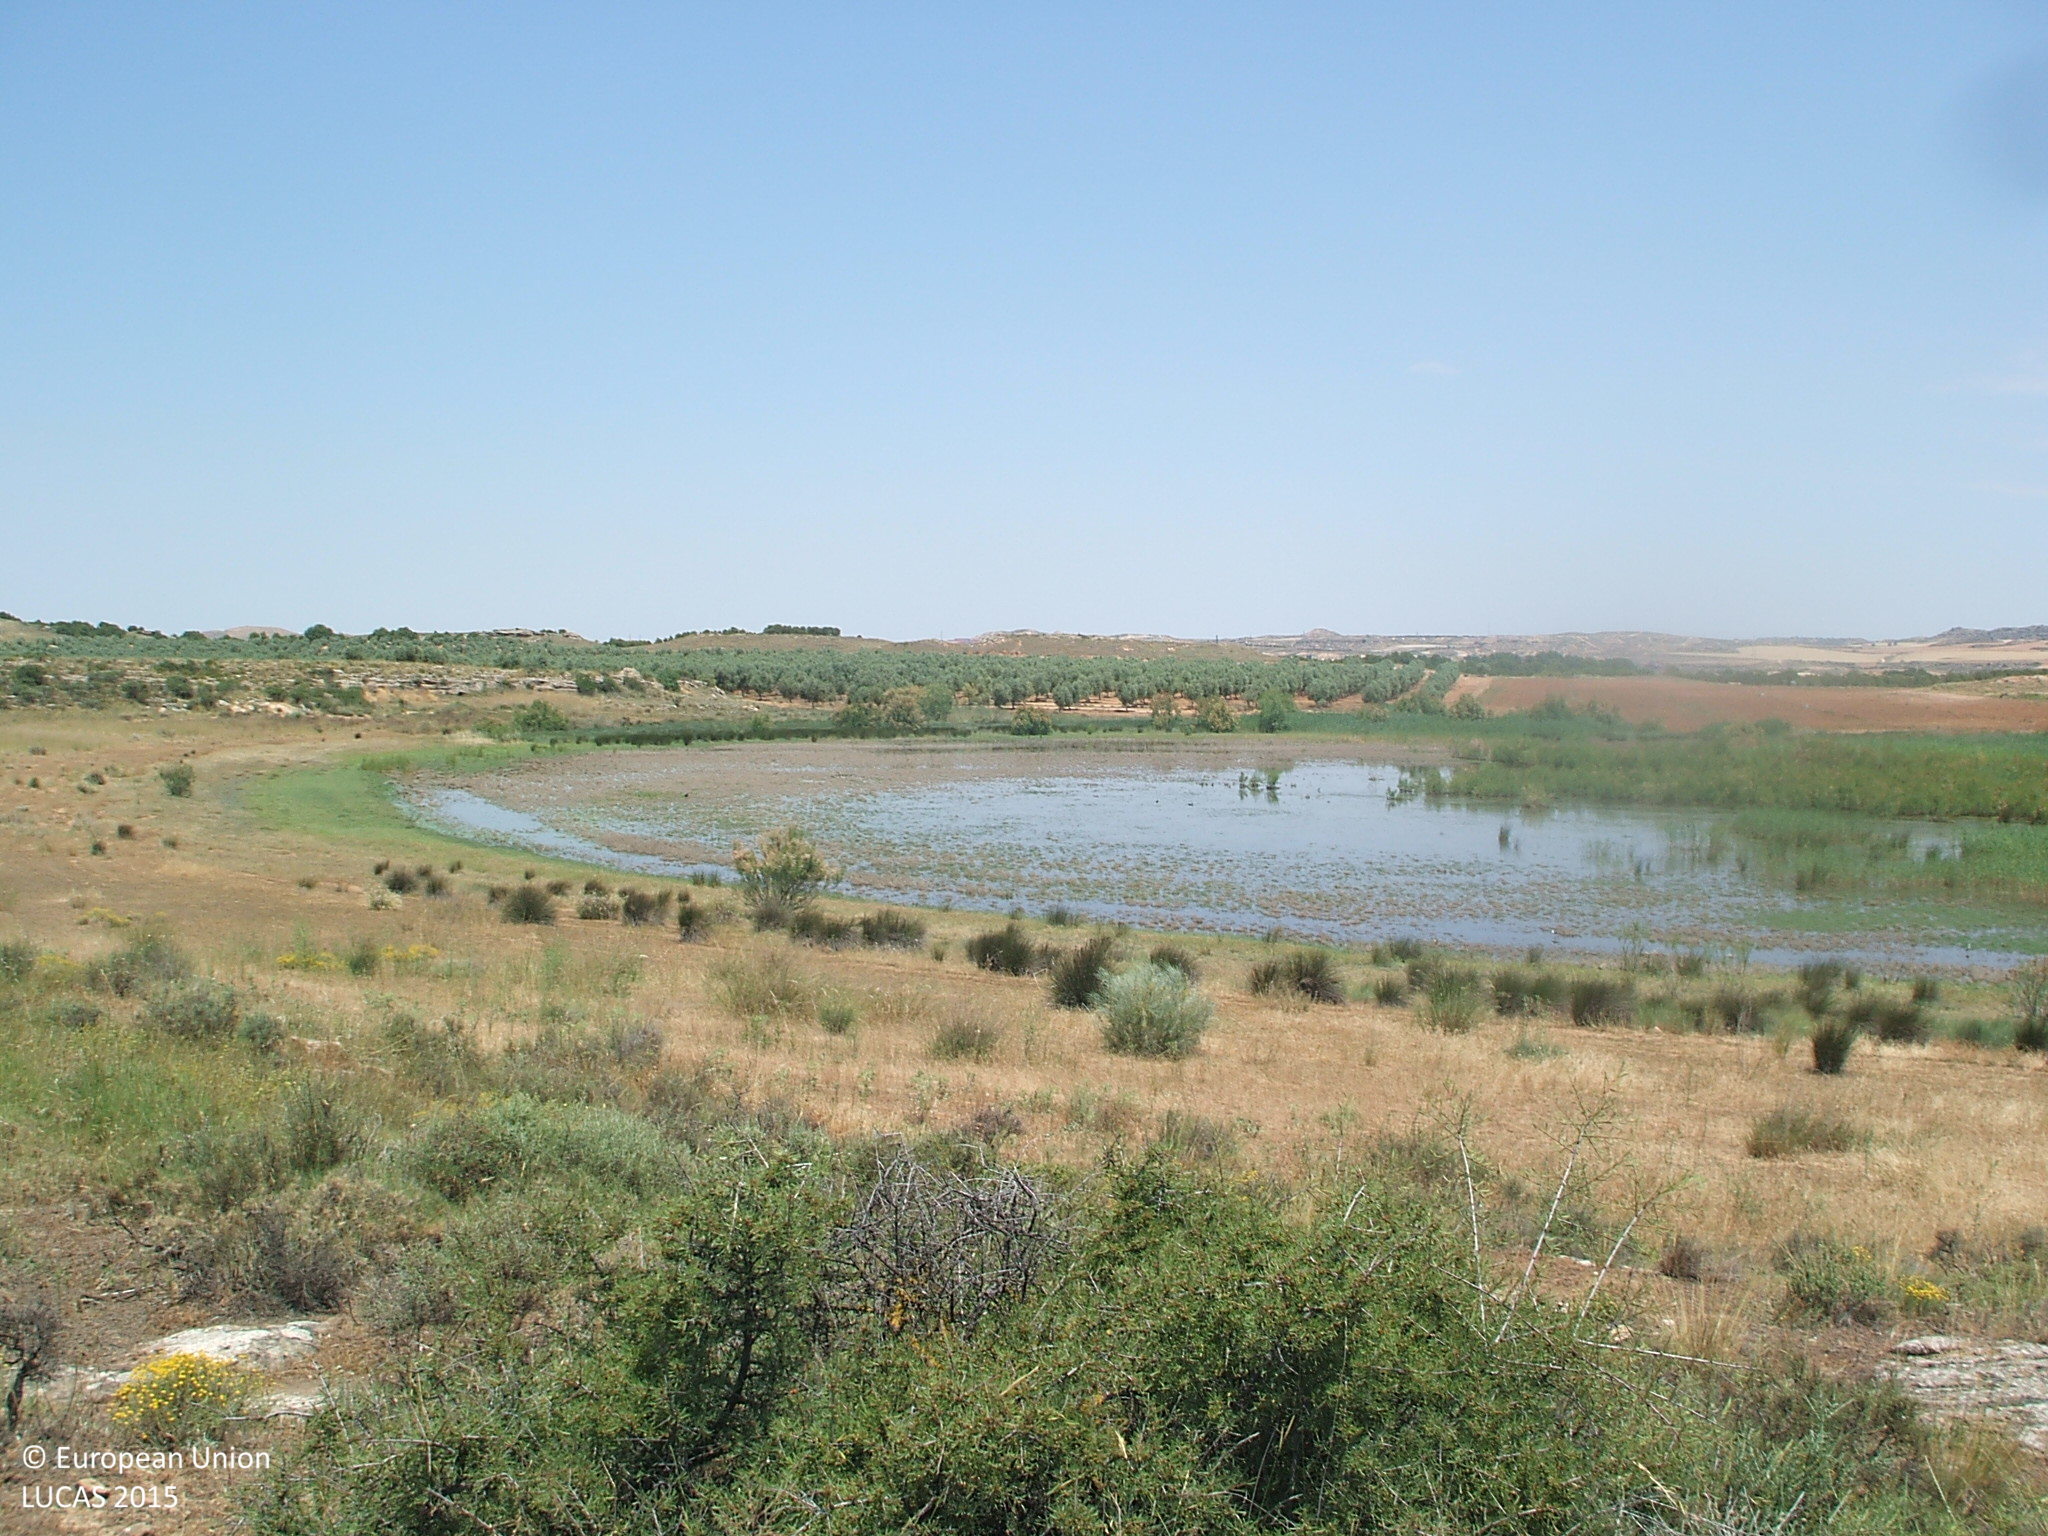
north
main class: Shrubland
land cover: Shrubland without tree cover
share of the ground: > 75 %
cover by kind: shrubs 90 %, herbaceous plants 10 %
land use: Semi-natural and natural areas not in use
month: June
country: ES
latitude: 41.0476
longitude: -0.1836
